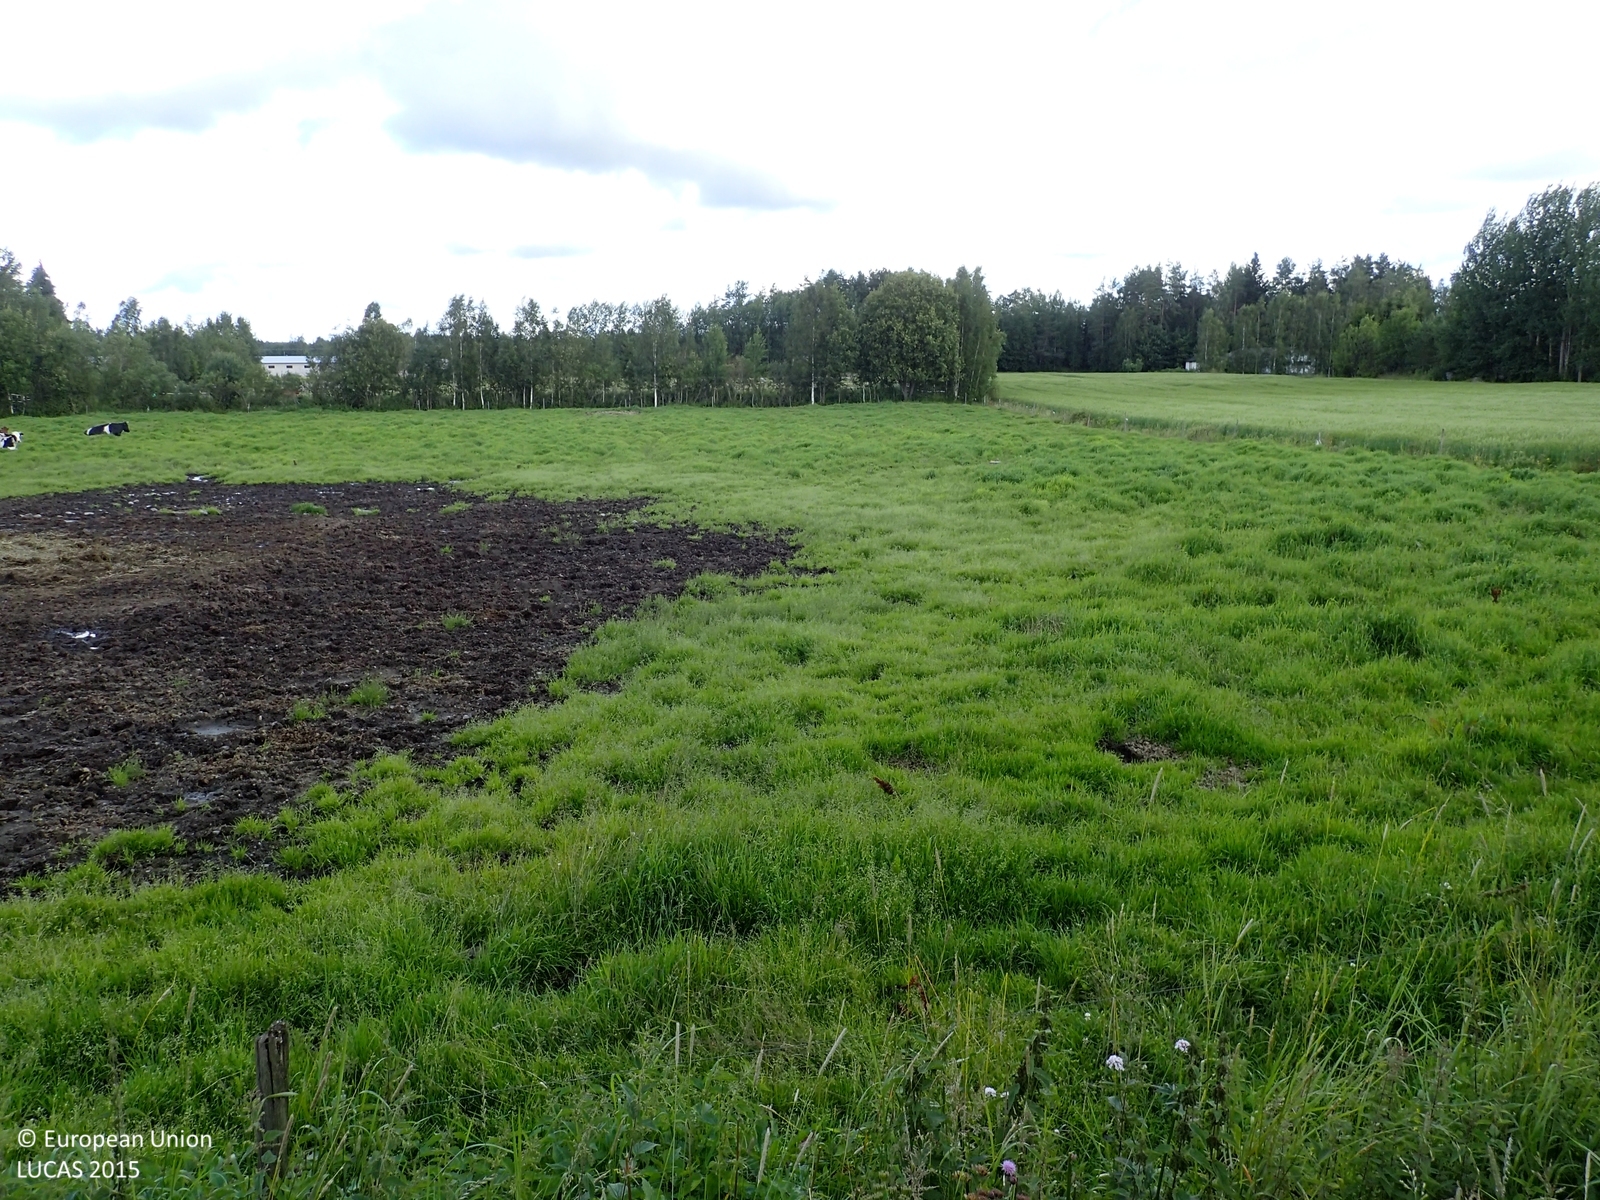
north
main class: Cropland
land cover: Temporary grasslands
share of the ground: > 75 %
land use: Agriculture (excluding fallow land and kitchen gardens)
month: August
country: FI
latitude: 62.7220
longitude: 21.9181
